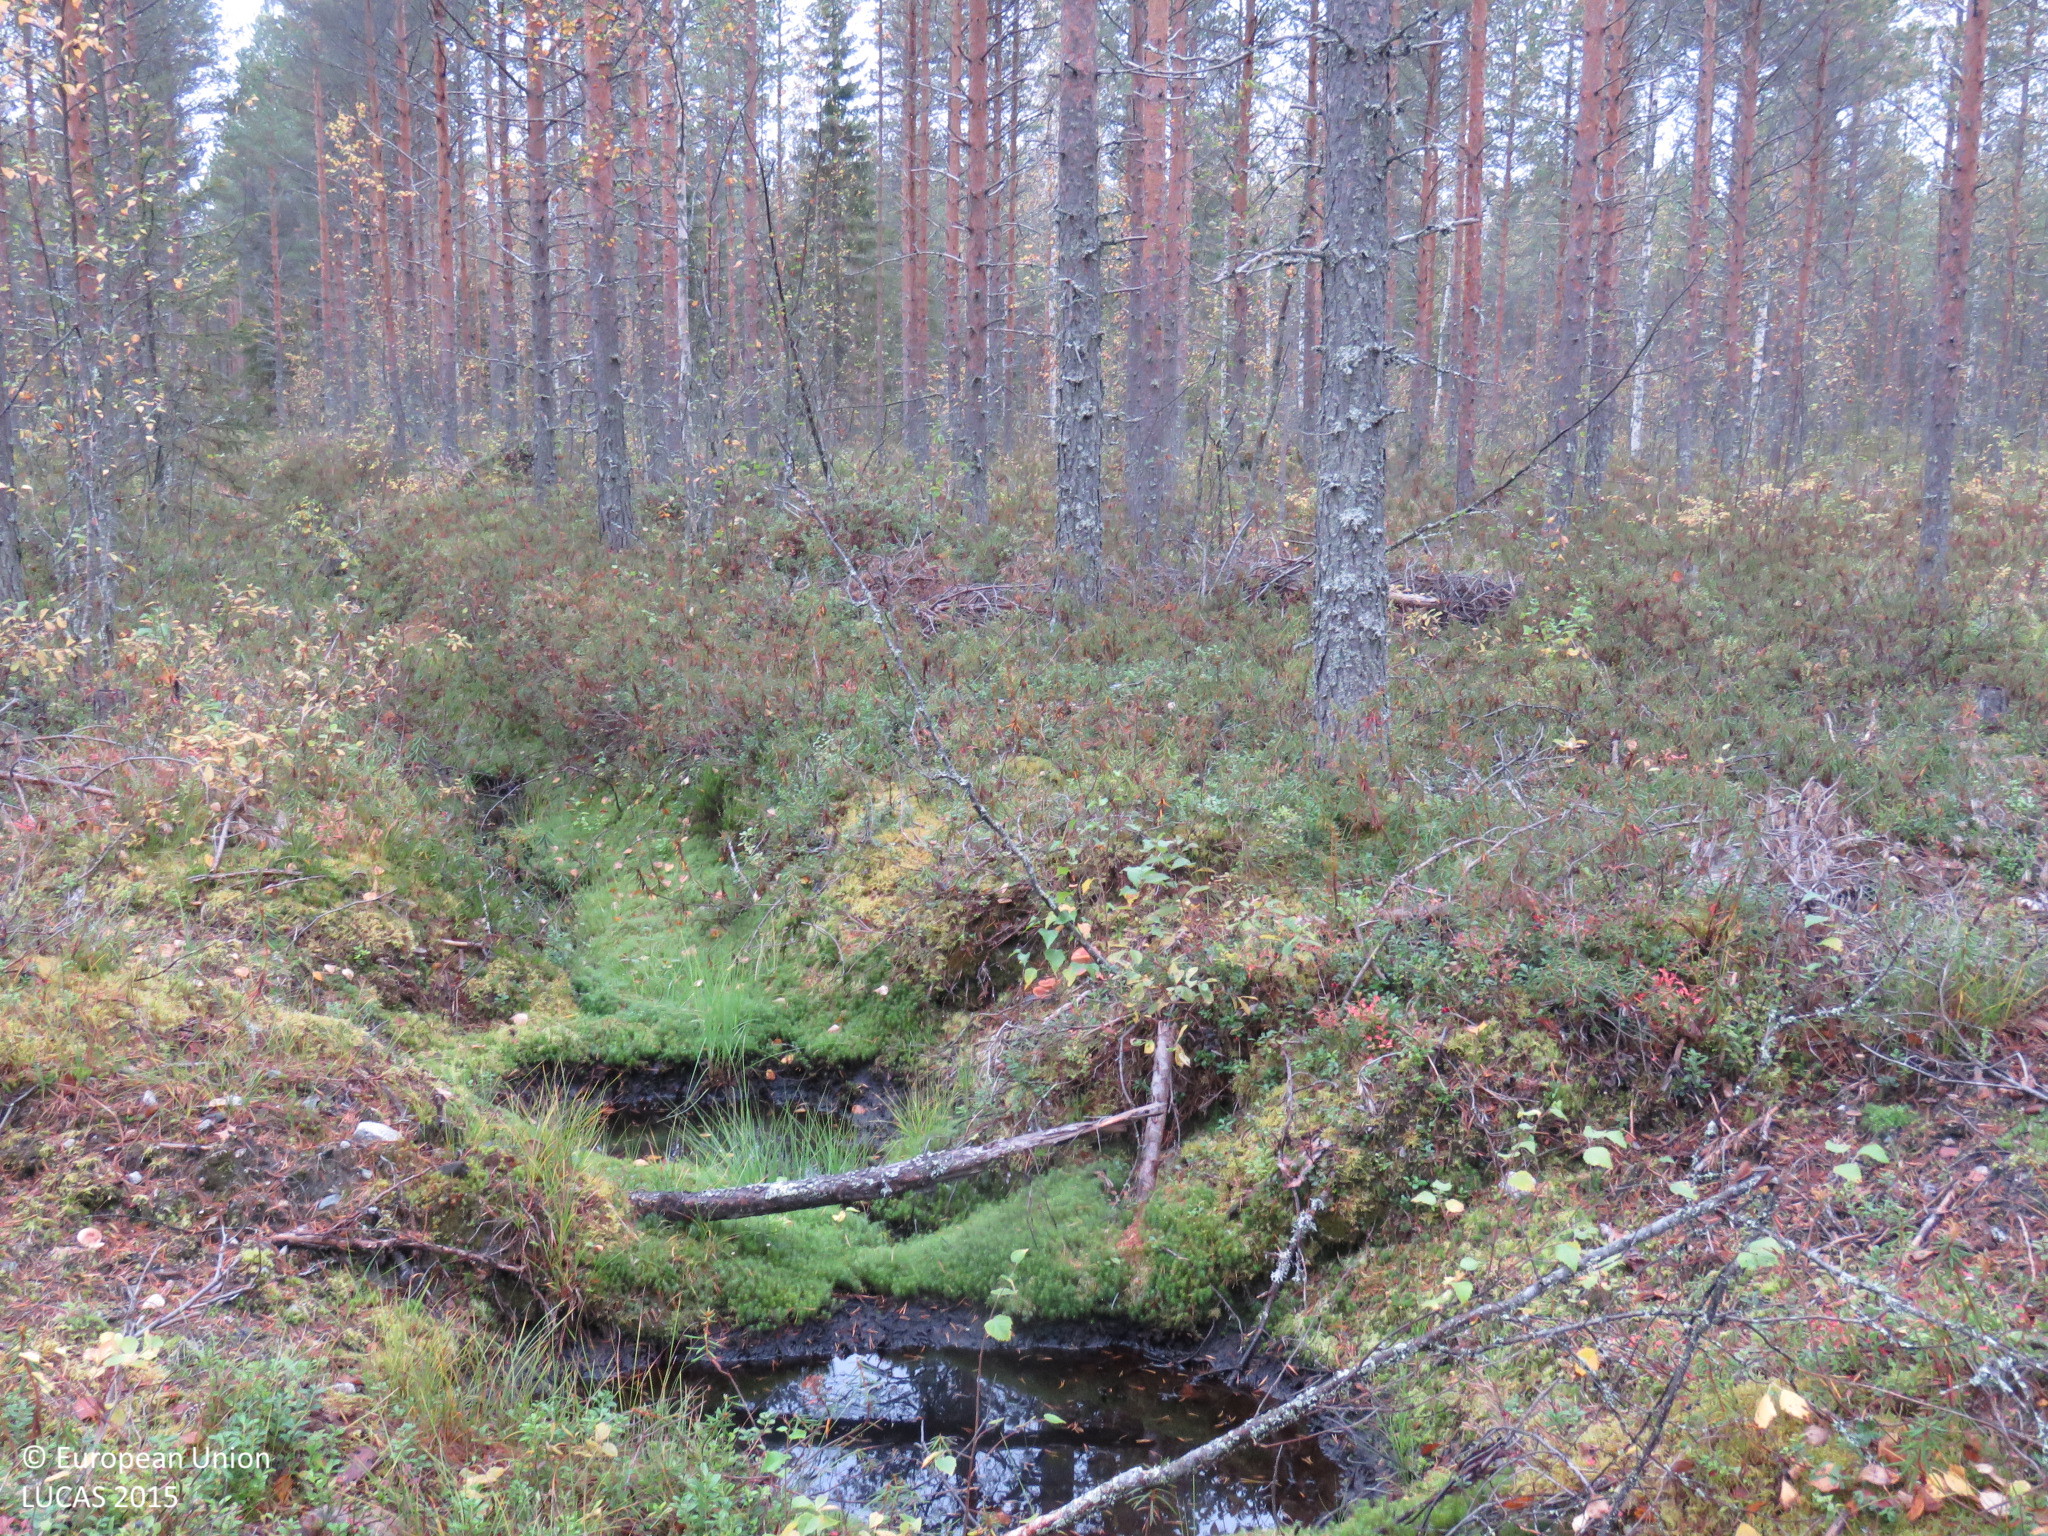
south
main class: Woodland
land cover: Pine dominated coniferous woodland
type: boreal forest
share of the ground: 50 - 75 %
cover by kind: coniferous forest trees 65 %, shrubs 20 %, lichens and mosses 10 %, broadleaved forest trees 5 %
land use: Forestry
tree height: > 5 m
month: September
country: FI
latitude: 64.8482
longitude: 26.9716
